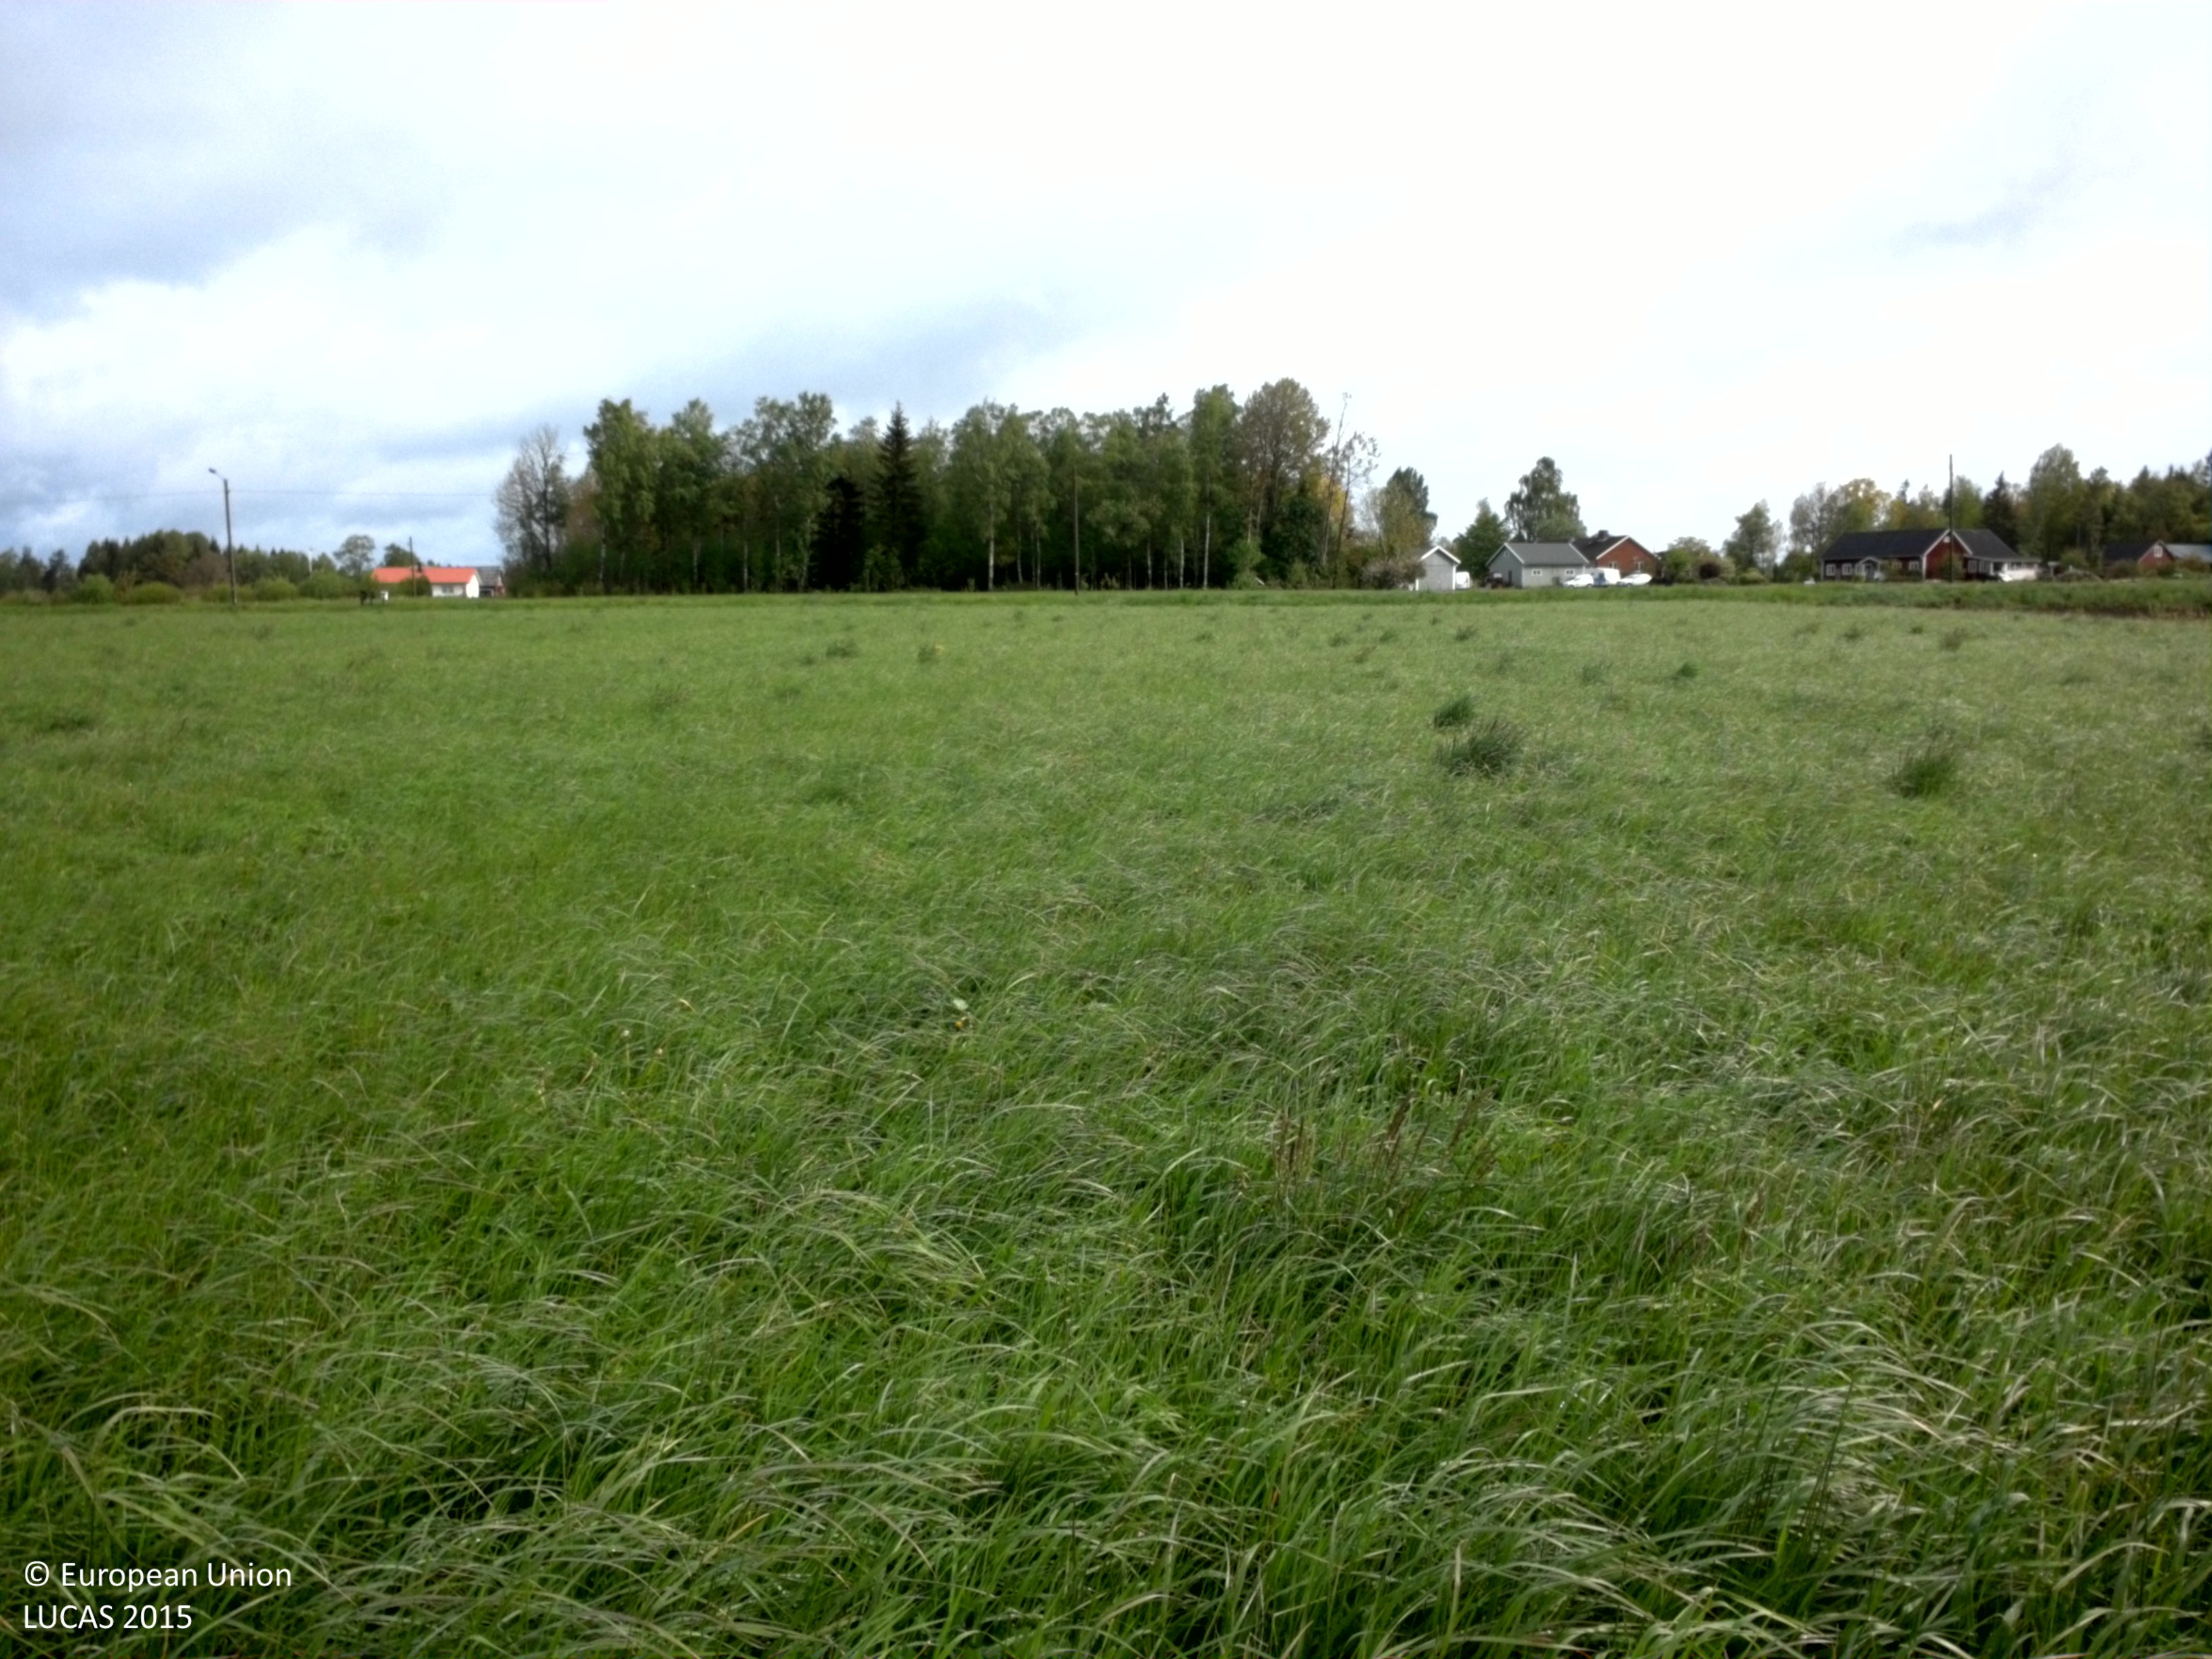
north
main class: Cropland
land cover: Temporary grasslands
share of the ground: > 75 %
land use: Agriculture (excluding fallow land and kitchen gardens)
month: June
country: SE
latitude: 56.7372
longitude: 14.5581
